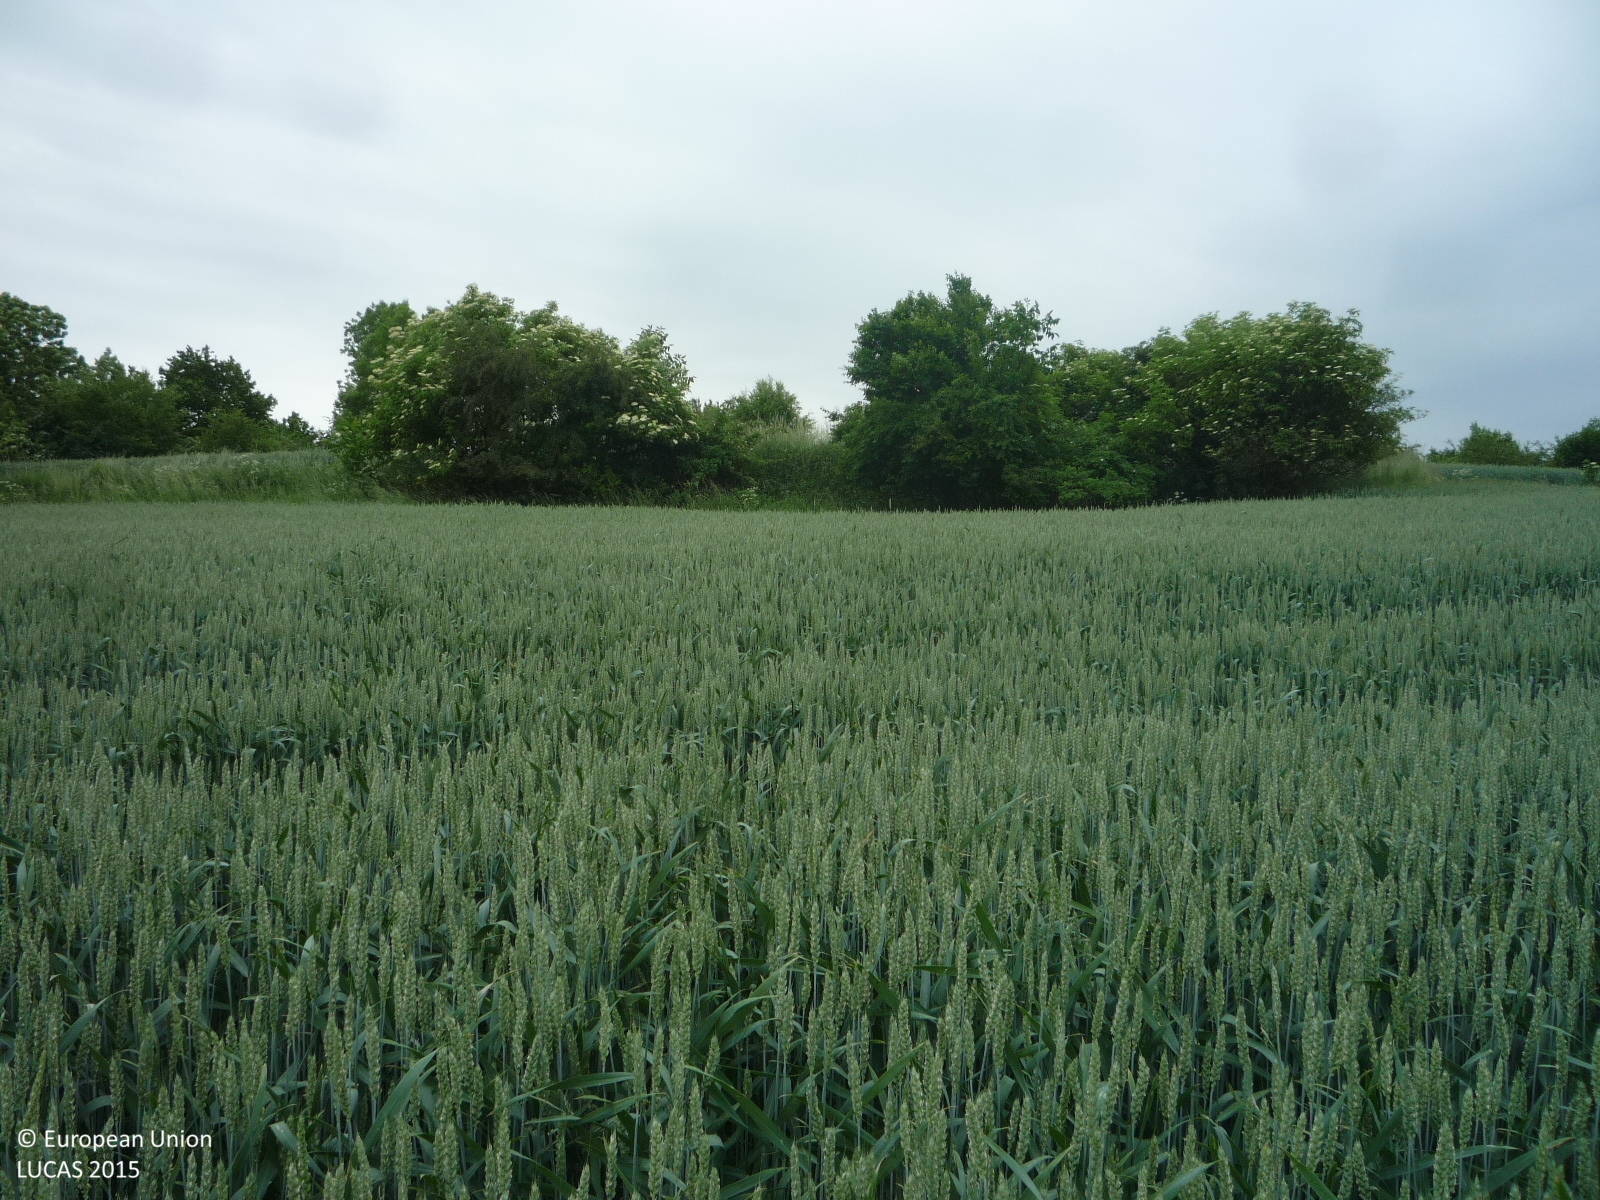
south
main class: Cropland
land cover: Common wheat
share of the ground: > 75 %
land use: Agriculture (excluding fallow land and kitchen gardens)
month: June
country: CZ
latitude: 50.2701
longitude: 14.1681
